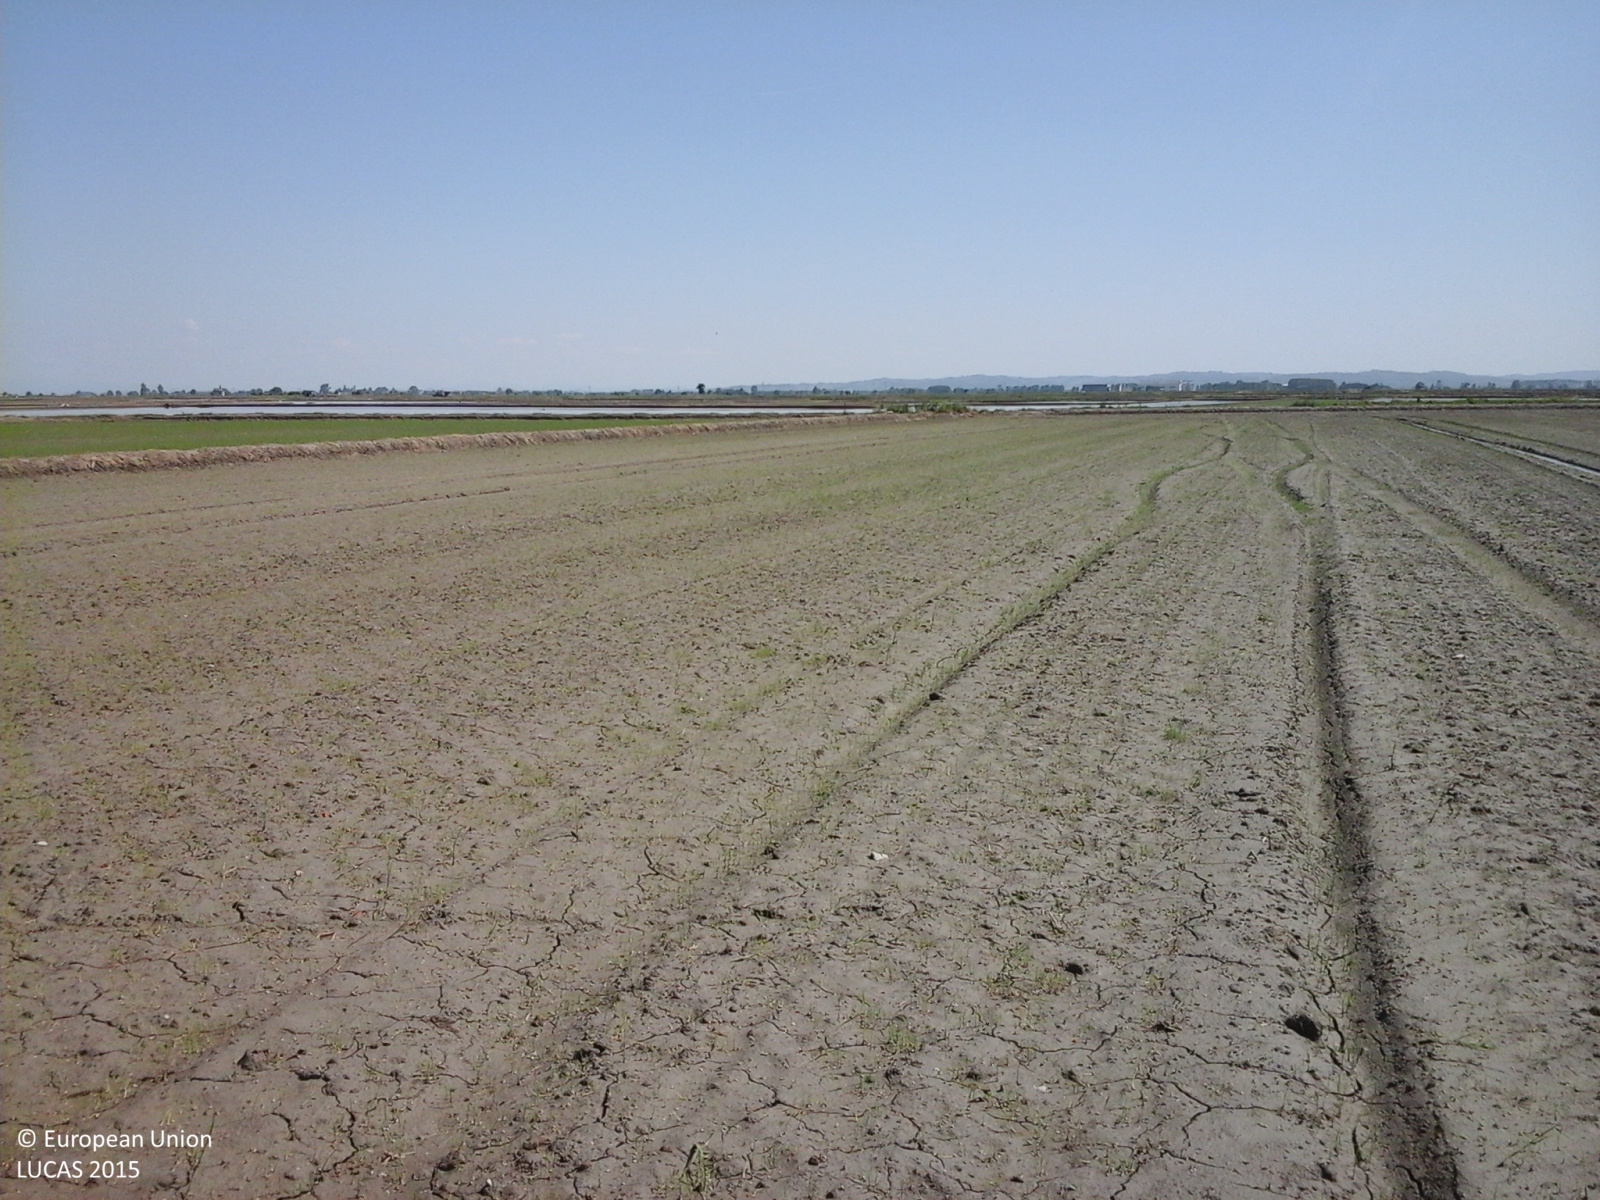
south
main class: Cropland
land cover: Rice
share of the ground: < 10 %
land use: Agriculture (excluding fallow land and kitchen gardens)
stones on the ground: < 10 %
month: May
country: IT
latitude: 45.2577
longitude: 8.3845
